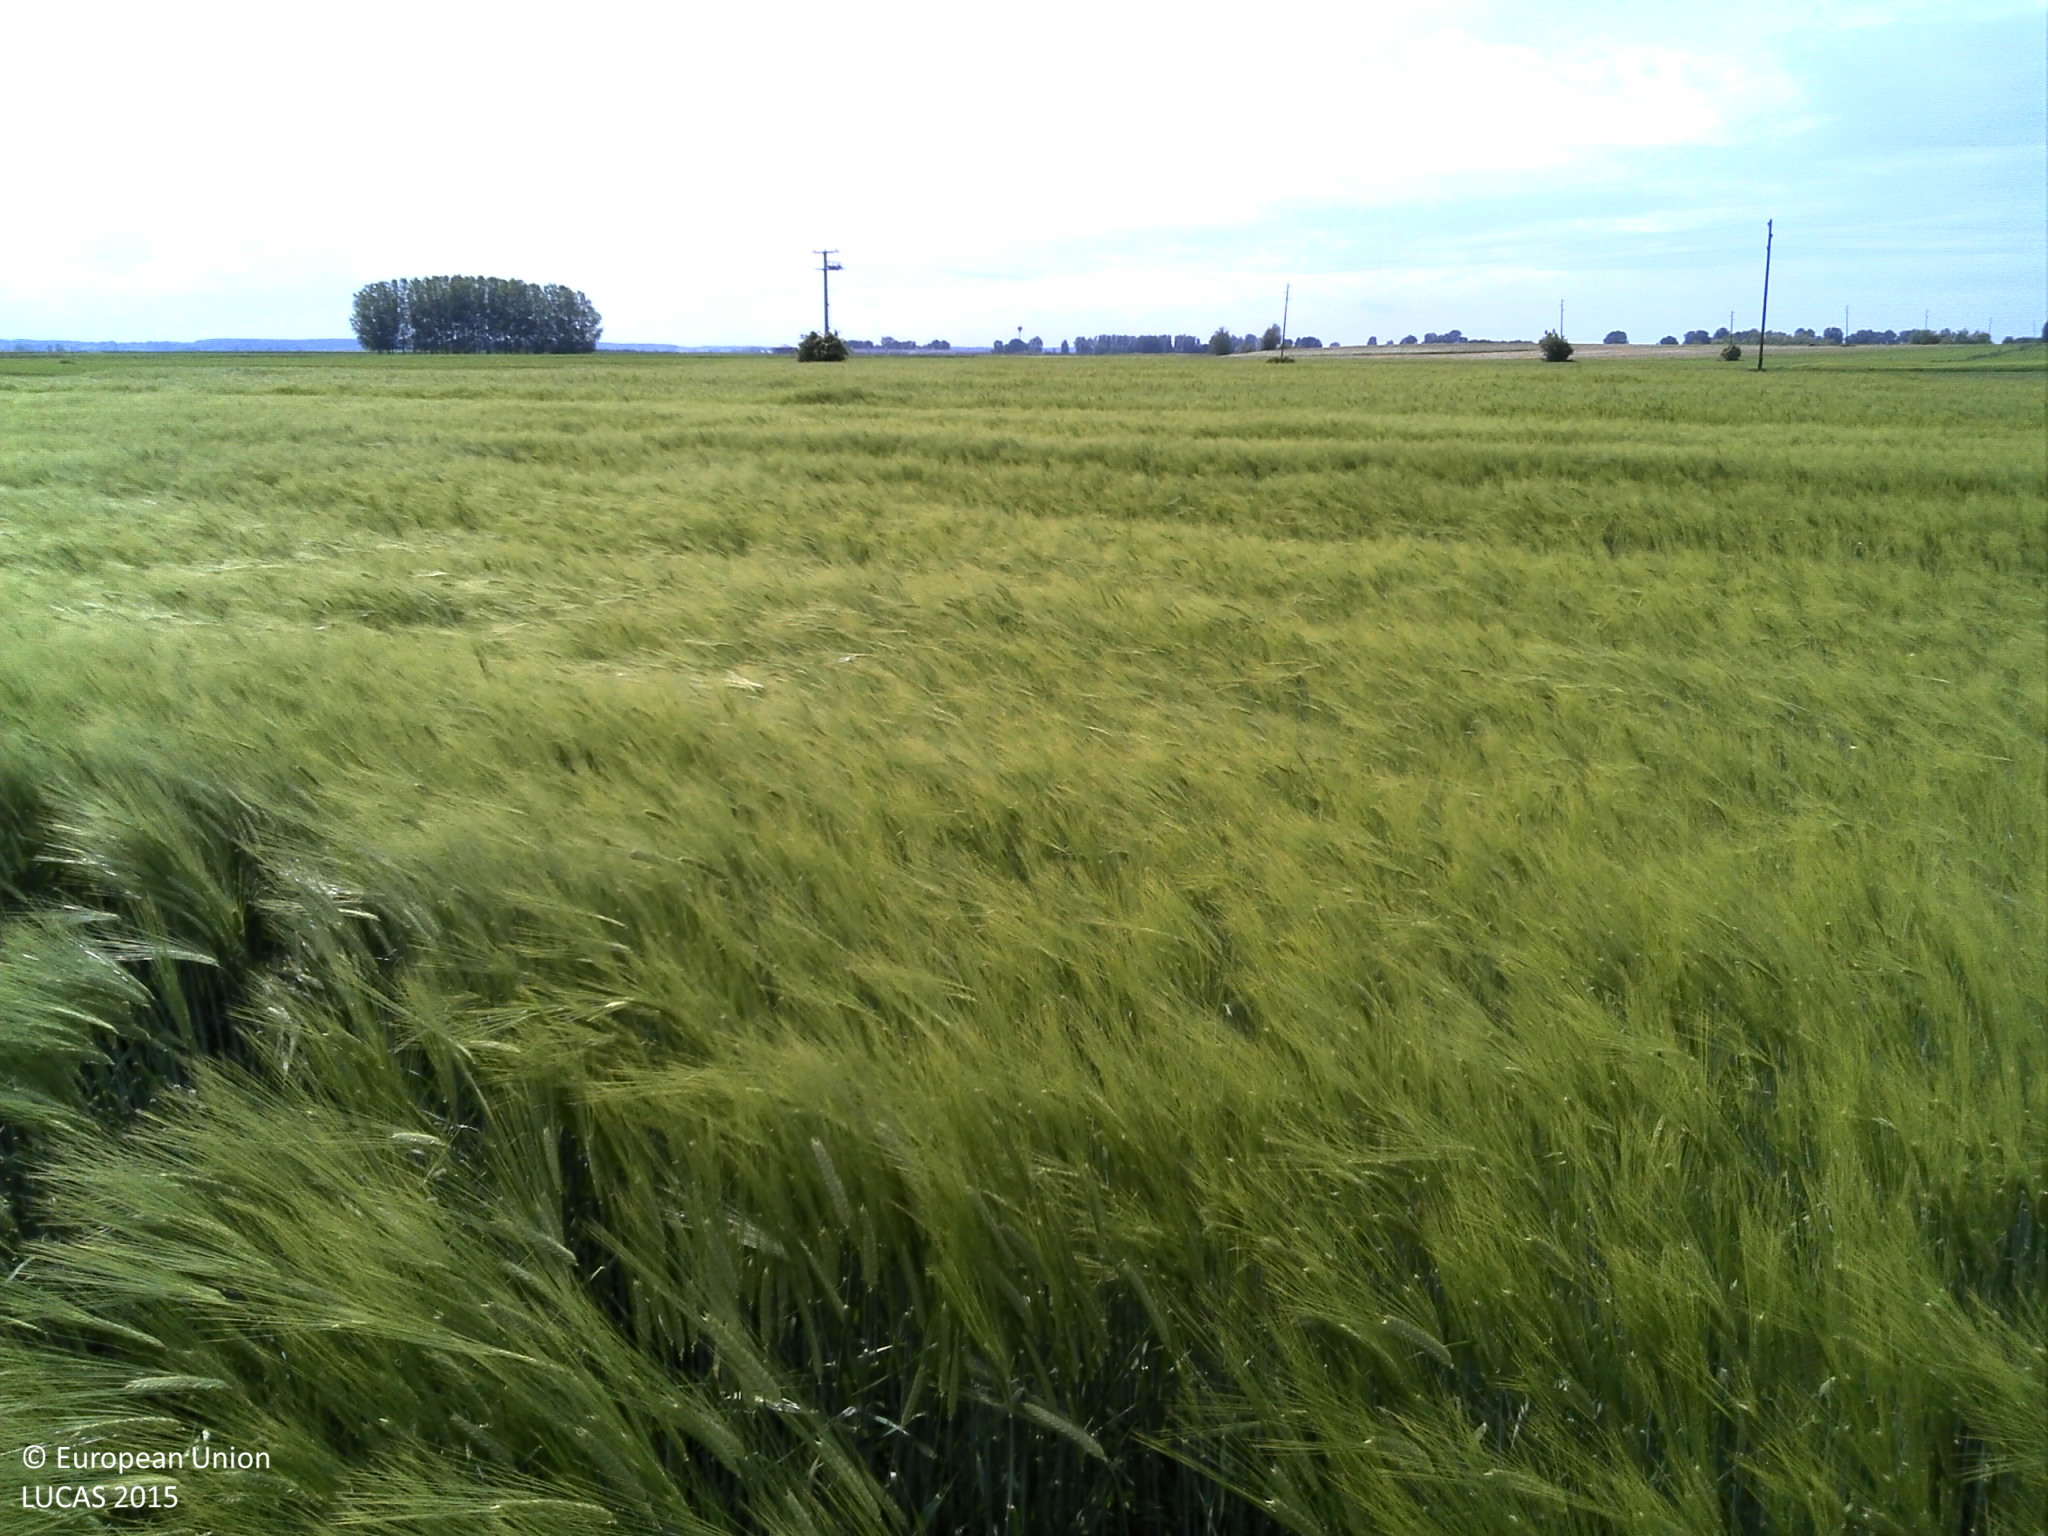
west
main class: Cropland
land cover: Barley
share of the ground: > 75 %
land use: Agriculture (excluding fallow land and kitchen gardens)
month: May
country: HR
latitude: 45.6545
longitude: 18.6702
